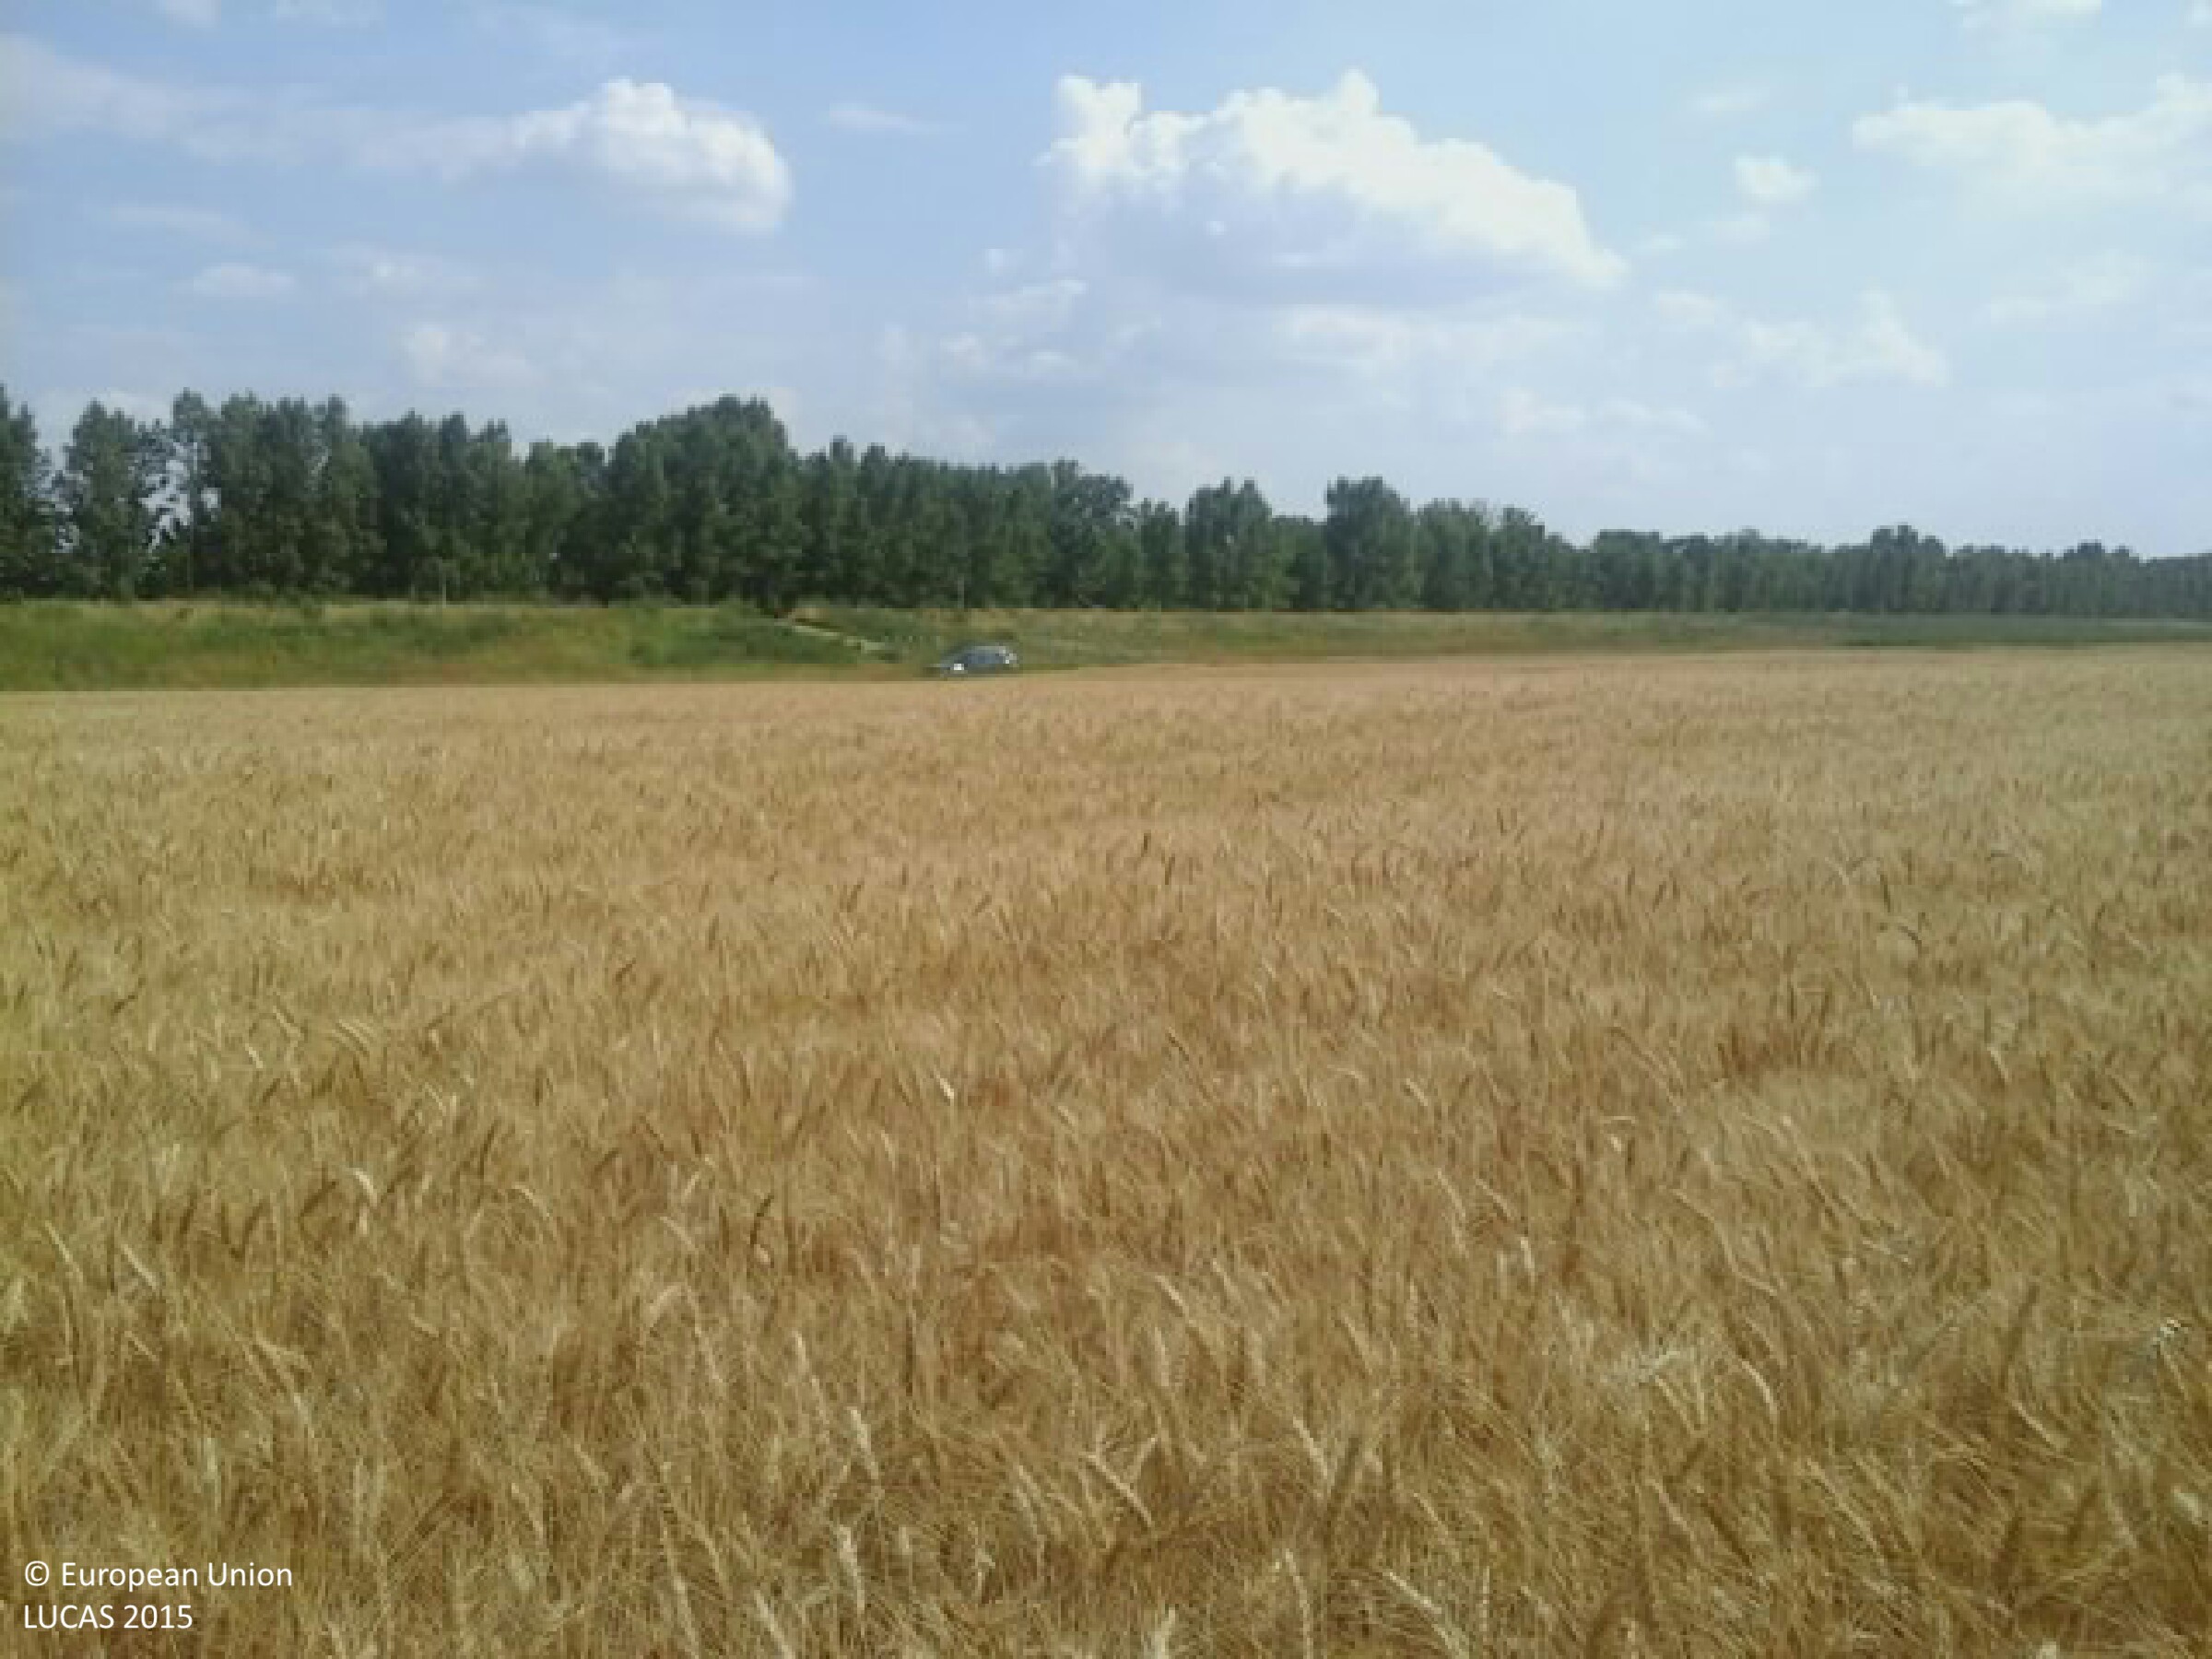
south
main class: Cropland
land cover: Common wheat
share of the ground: > 75 %
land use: Agriculture (excluding fallow land and kitchen gardens)
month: July
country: HU
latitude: 46.6624
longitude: 18.9664
